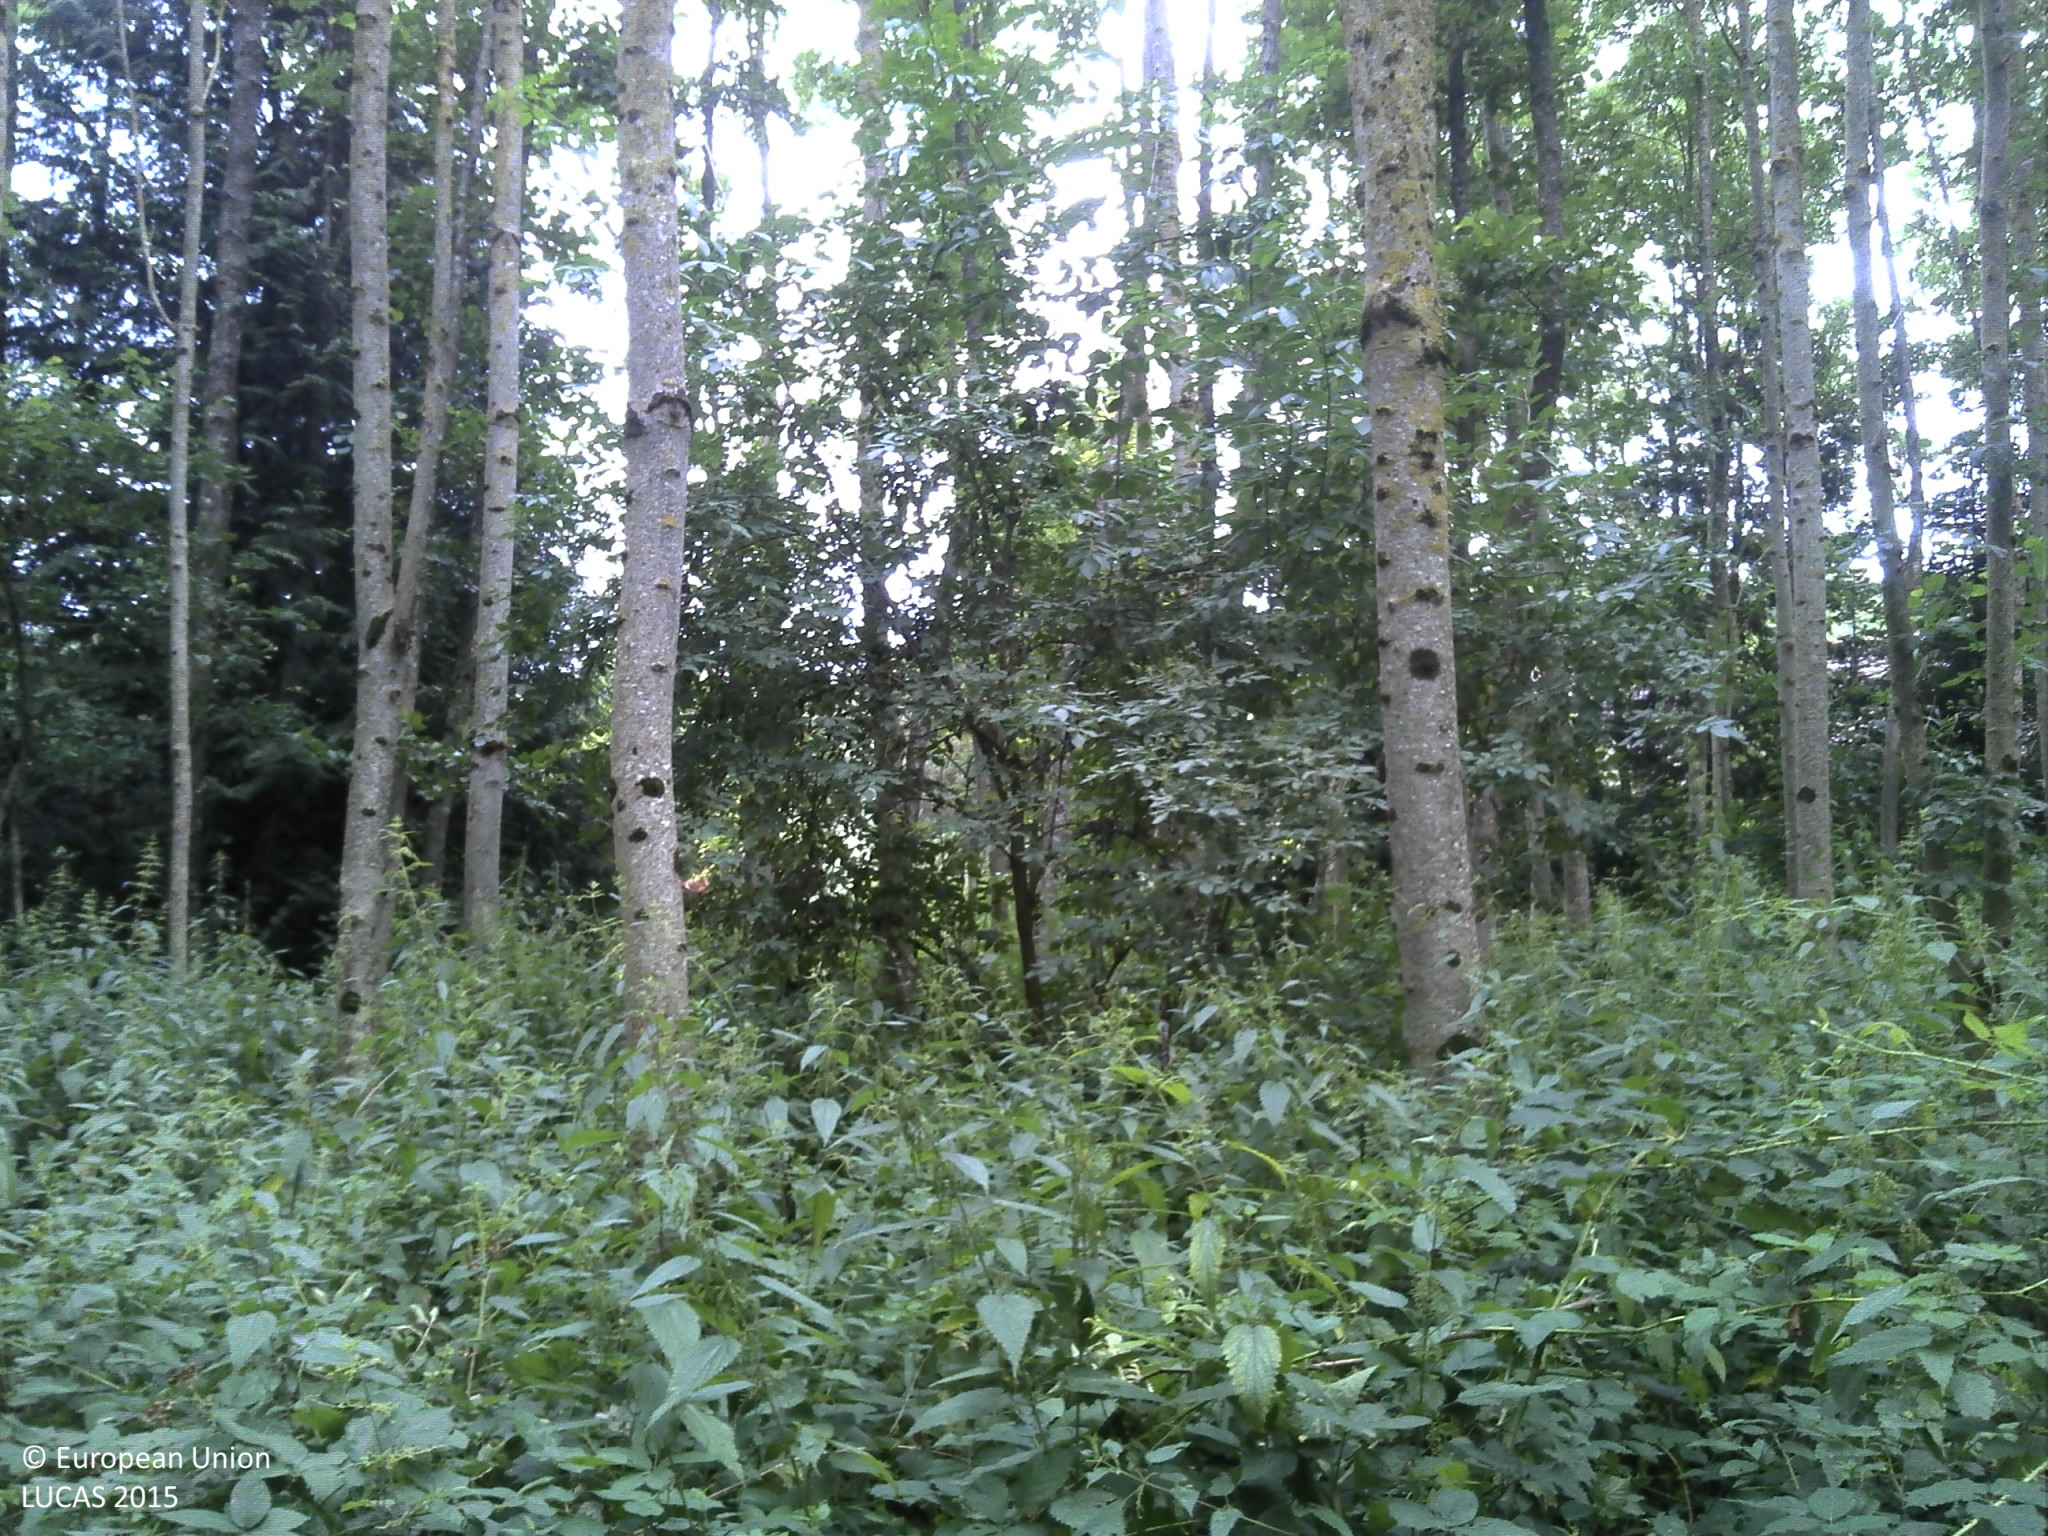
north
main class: Woodland
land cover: Broadleaved woodland
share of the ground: > 75 %
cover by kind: broadleaved forest trees 70 %, herbaceous plants 30 %
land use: Forestry
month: July
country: FR
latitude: 49.4463
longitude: 4.6589
